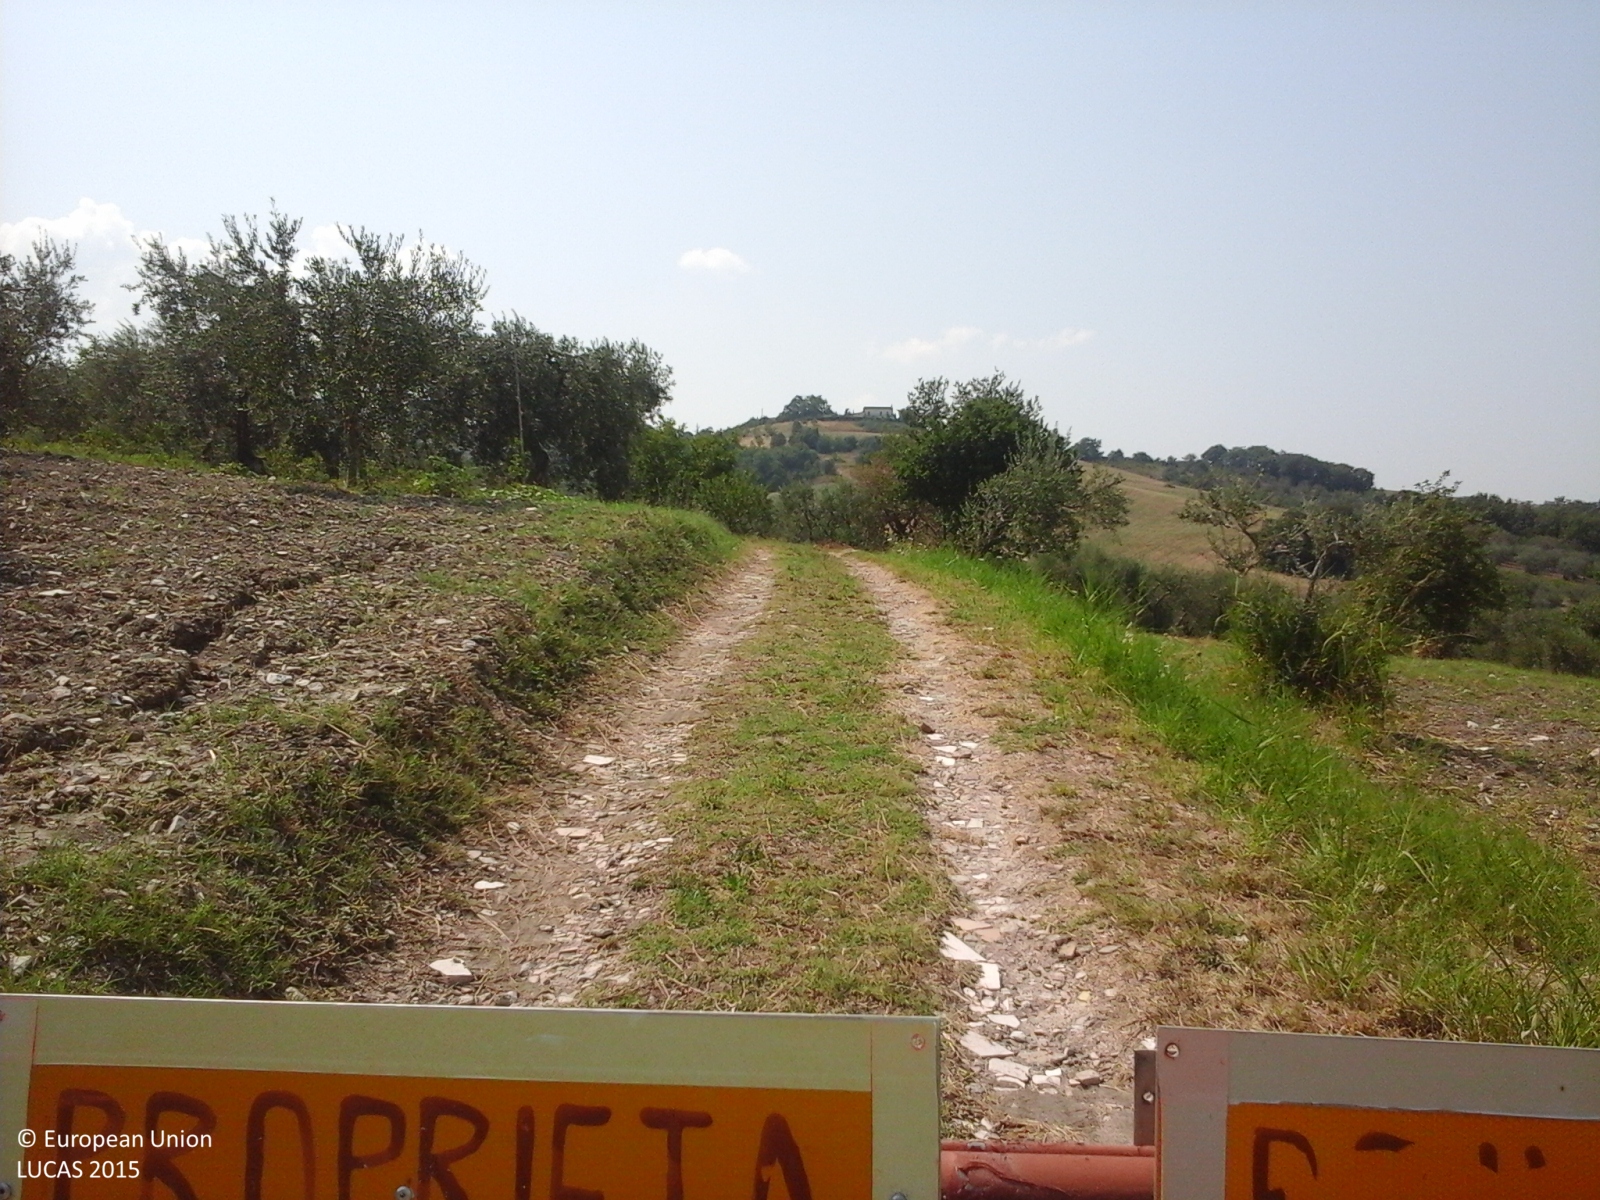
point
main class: Cropland
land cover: Olive groves
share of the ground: 50 - 75 %
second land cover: Spontaneously vegetated surfaces
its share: > 75 %
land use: Agriculture (excluding fallow land and kitchen gardens)
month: August
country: IT
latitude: 41.3988
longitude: 15.1851
